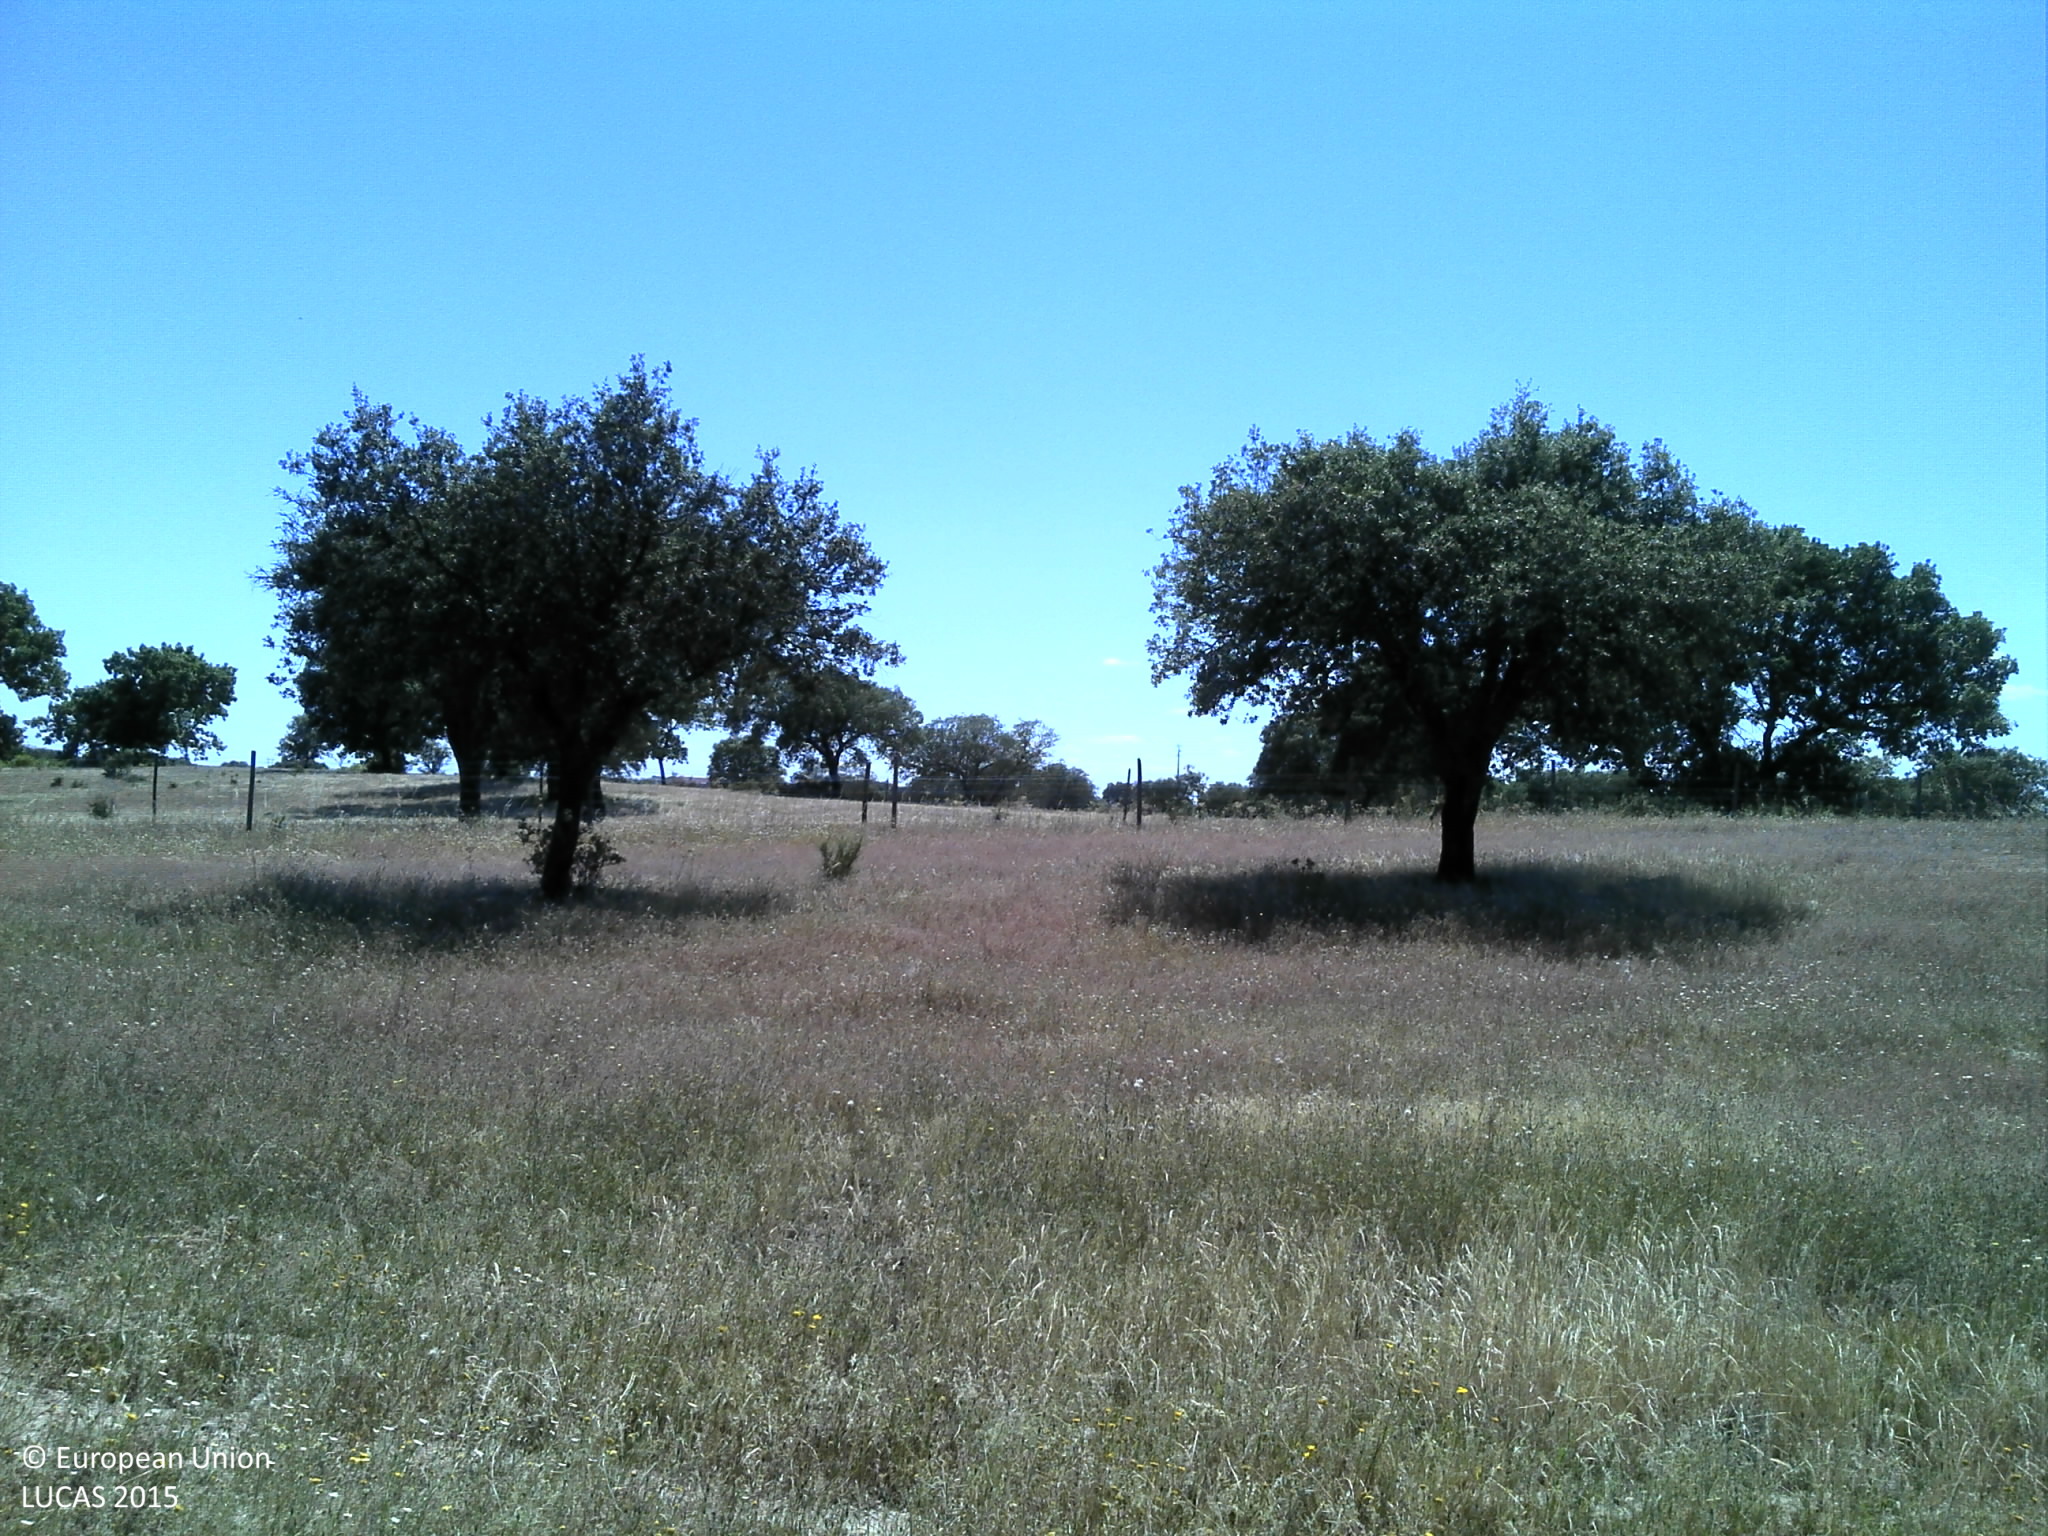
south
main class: Woodland
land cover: Broadleaved woodland
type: broadleaved evergreen forest
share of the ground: 25 - 50 %
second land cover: Shrubland without tree cover
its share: 50 - 75 %
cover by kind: broadleaved forest trees 40 %, shrubs 40 %, herbaceous plants 10 %, unconsolidated bare surface 10 %
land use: Forestry
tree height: > 5 m
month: May
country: PT
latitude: 39.4295
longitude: -7.7445
